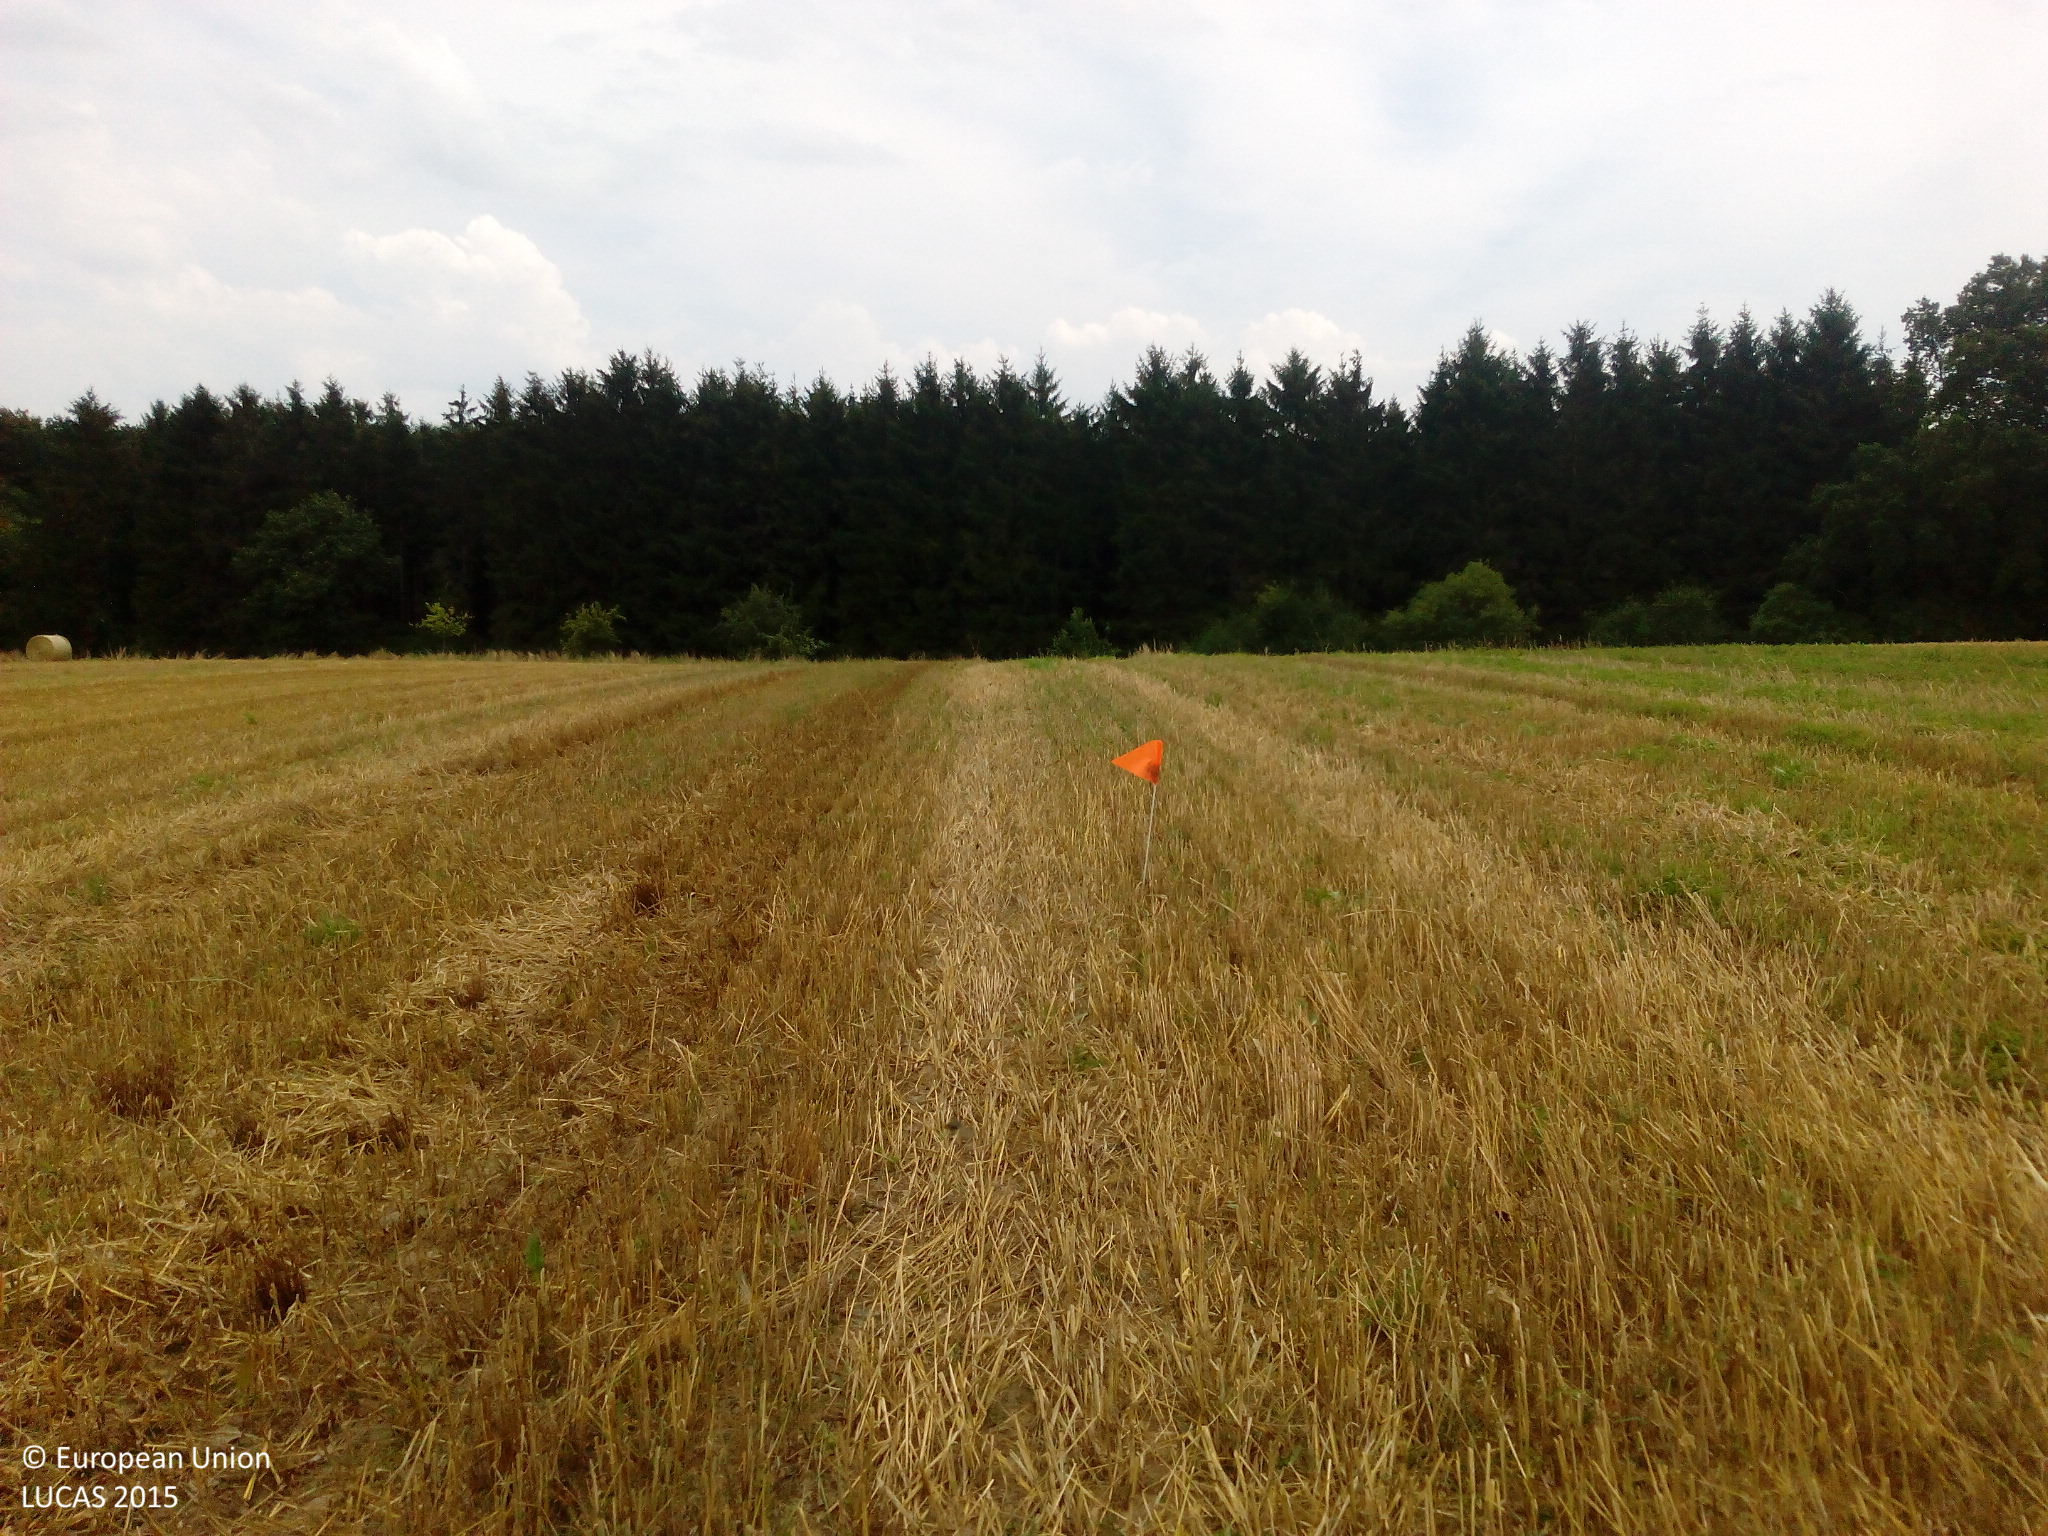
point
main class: Cropland
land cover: Barley
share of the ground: < 10 %
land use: Agriculture (excluding fallow land and kitchen gardens)
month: August
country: DE
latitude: 51.8364
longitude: 9.3471
